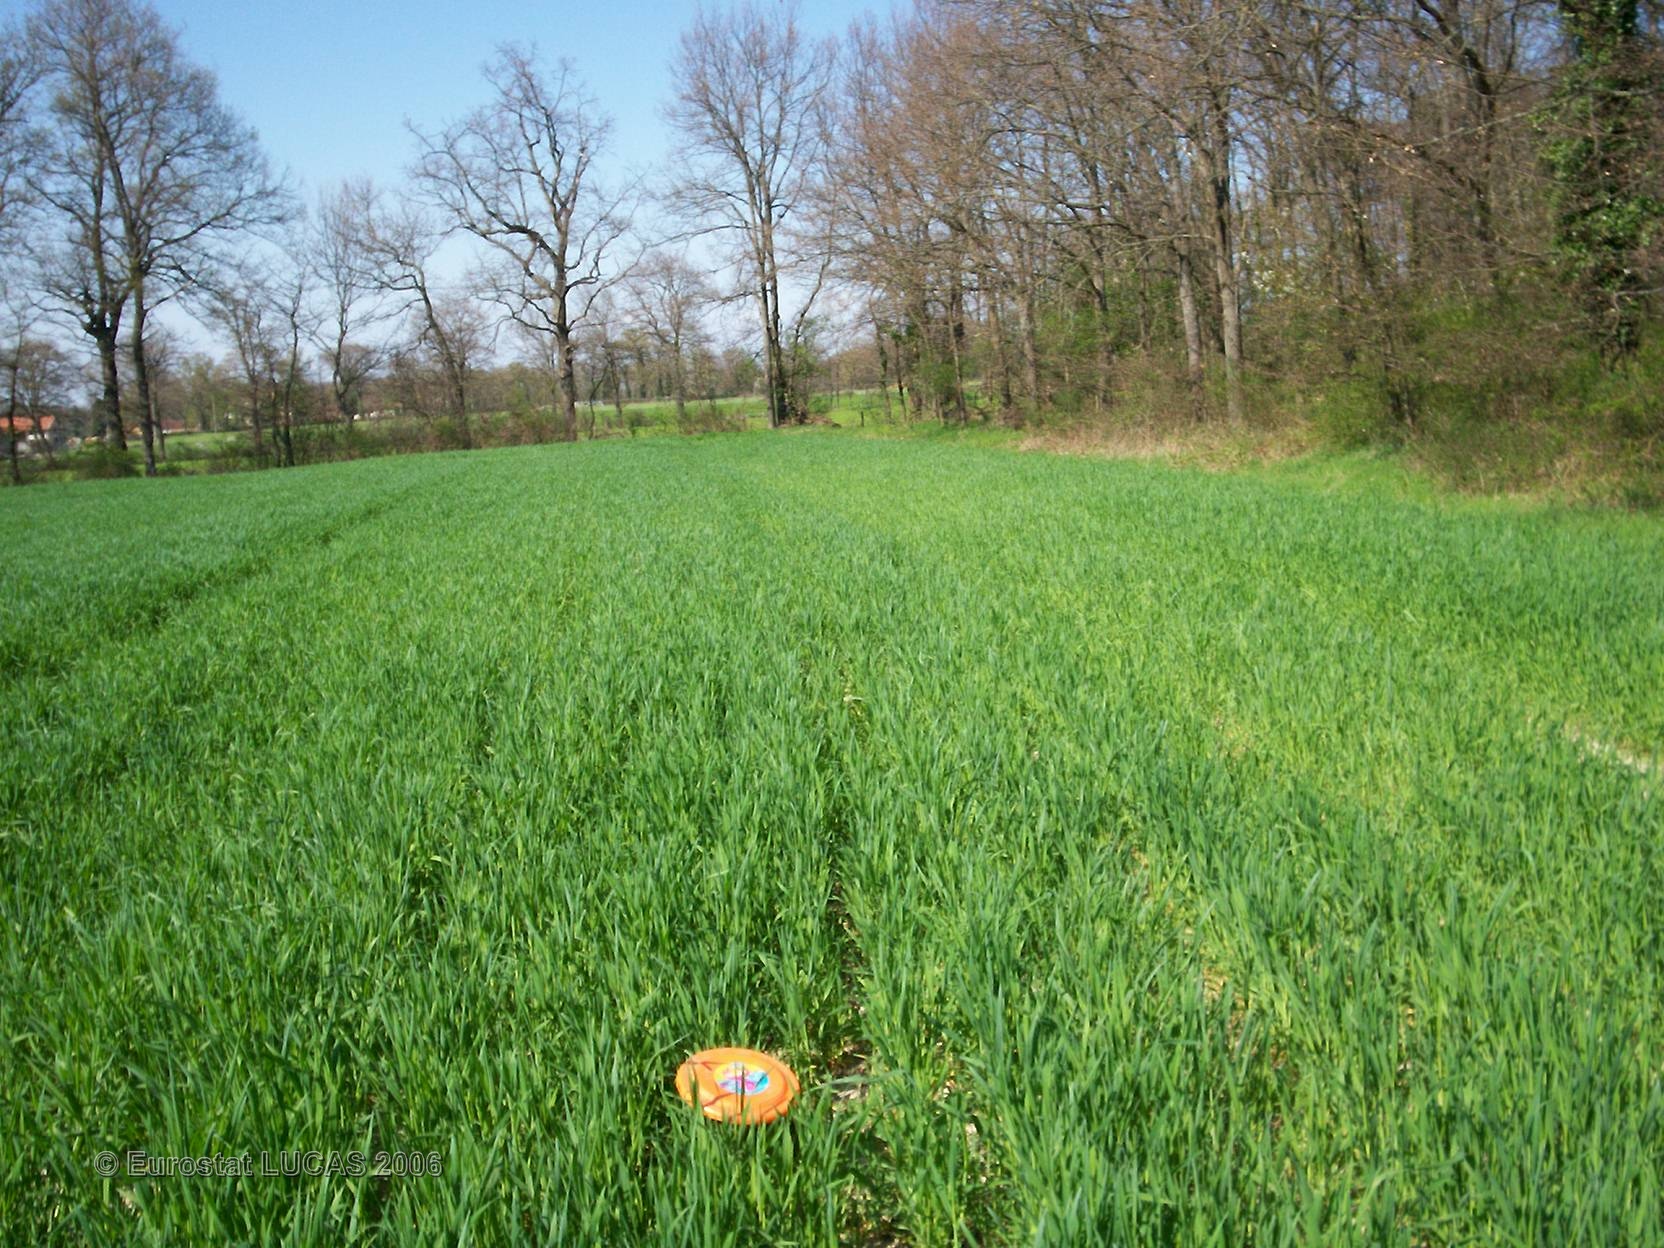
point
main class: Cropland
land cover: Common wheat
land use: Agriculture (excluding fallow land and kitchen gardens)
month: April
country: FR
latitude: 45.6666
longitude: 4.1369
